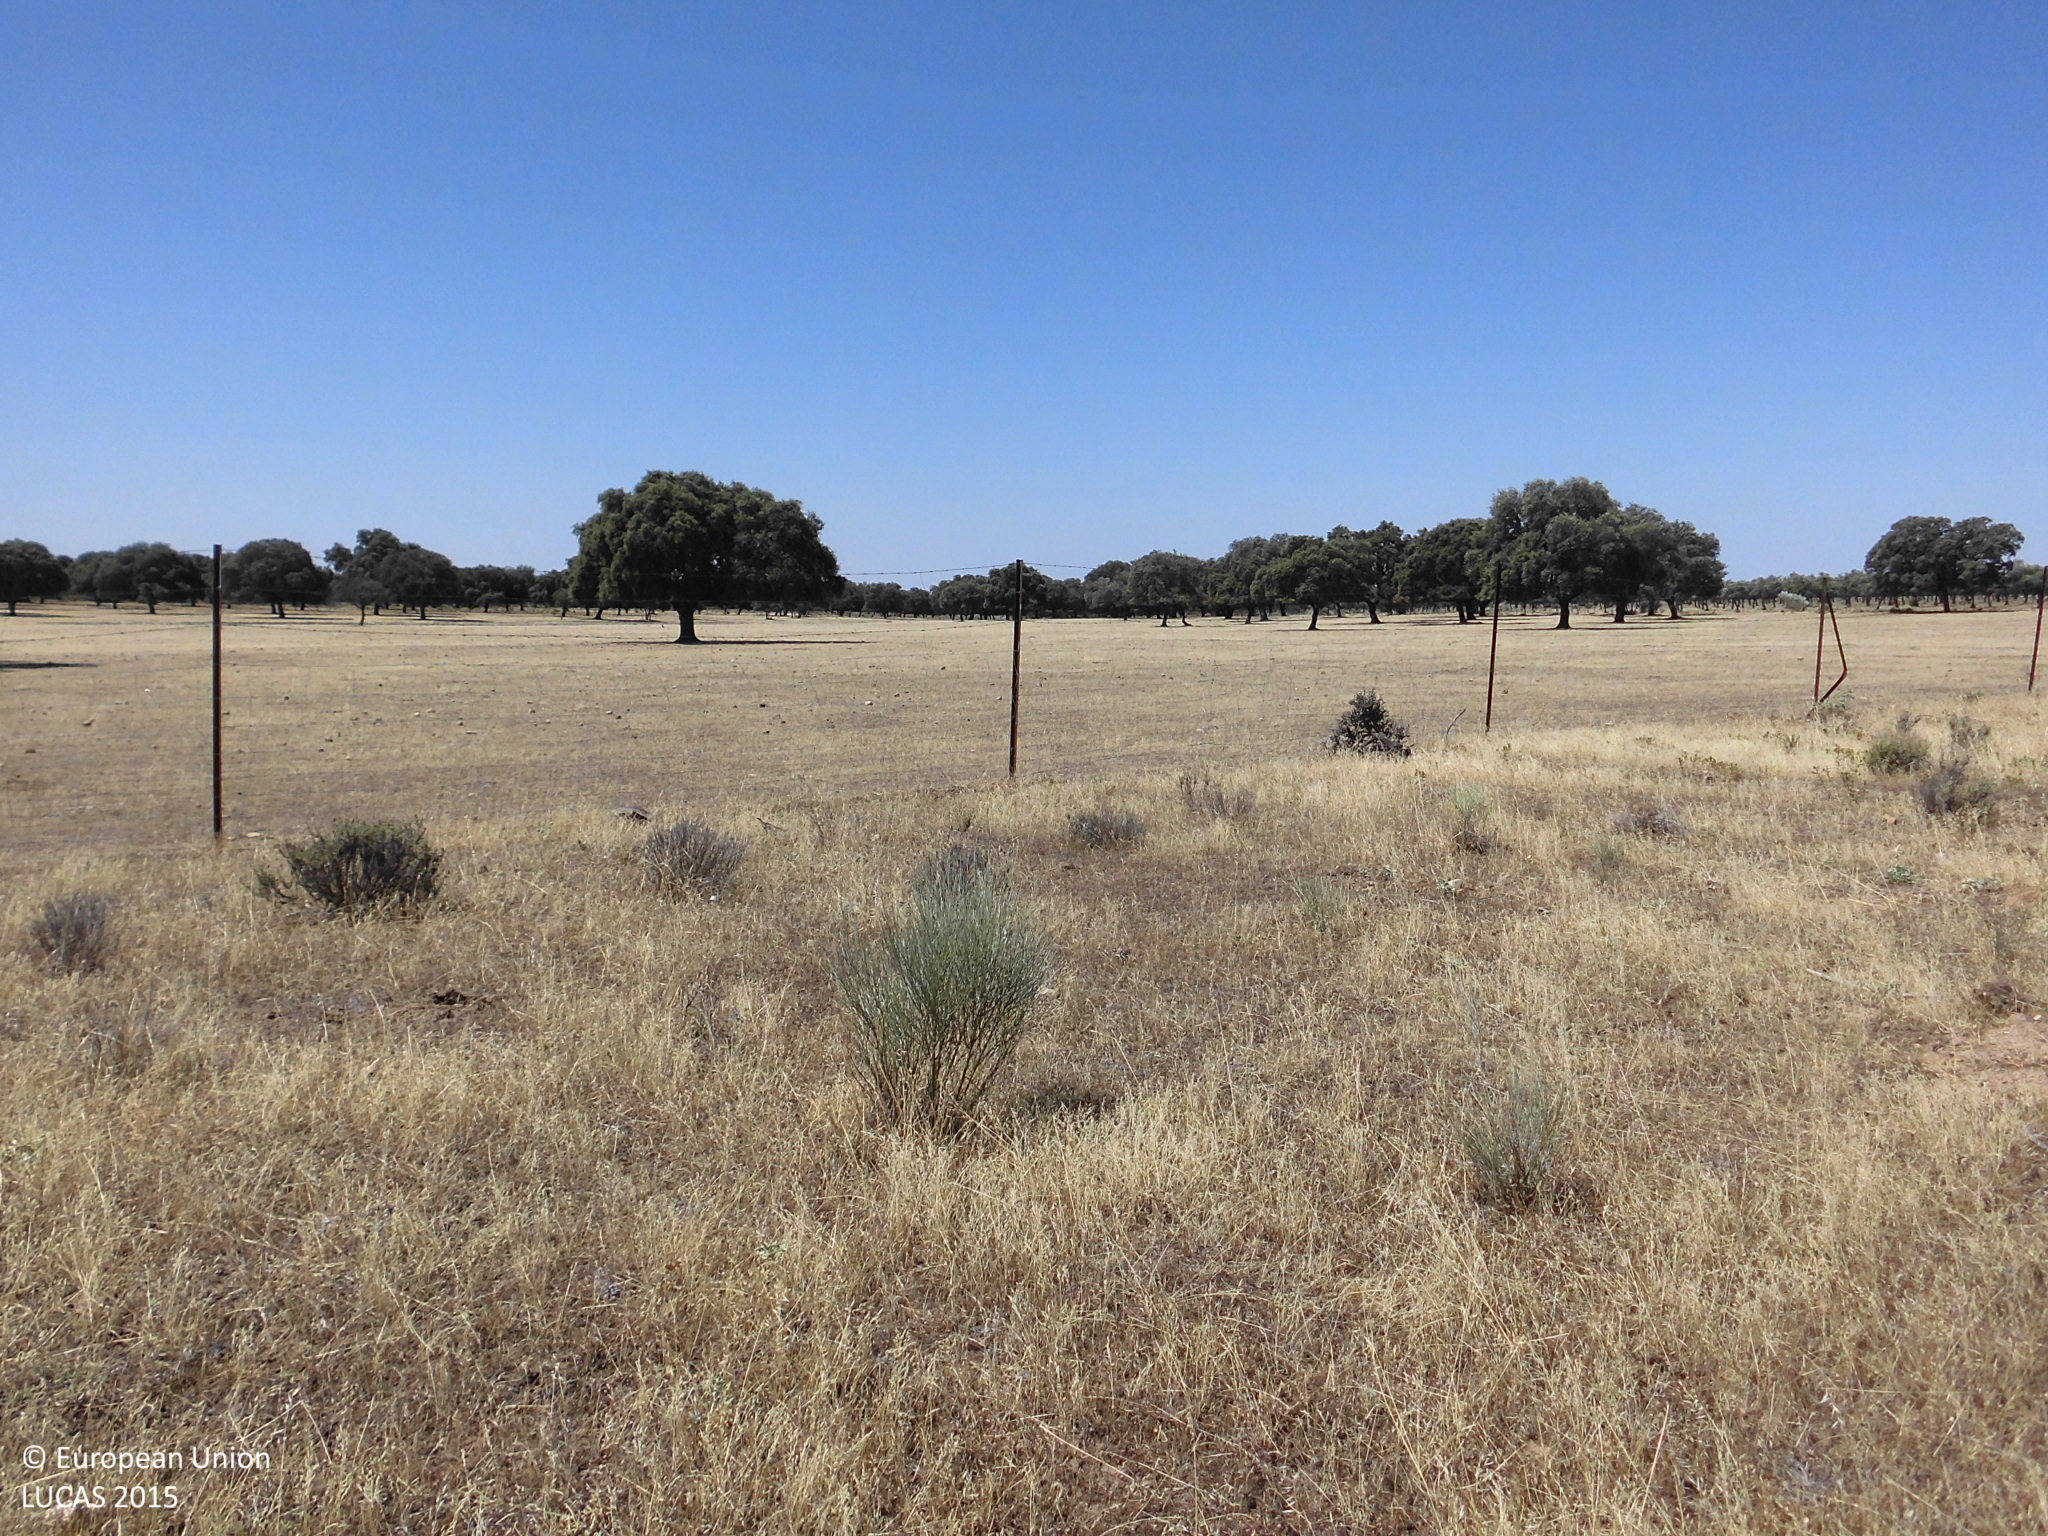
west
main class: Grassland
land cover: Grassland without tree/shrub cover
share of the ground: > 75 %
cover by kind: herbaceous plants 100 %
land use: Agriculture (excluding fallow land and kitchen gardens)
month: June
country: ES
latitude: 39.7056
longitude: -5.9609
